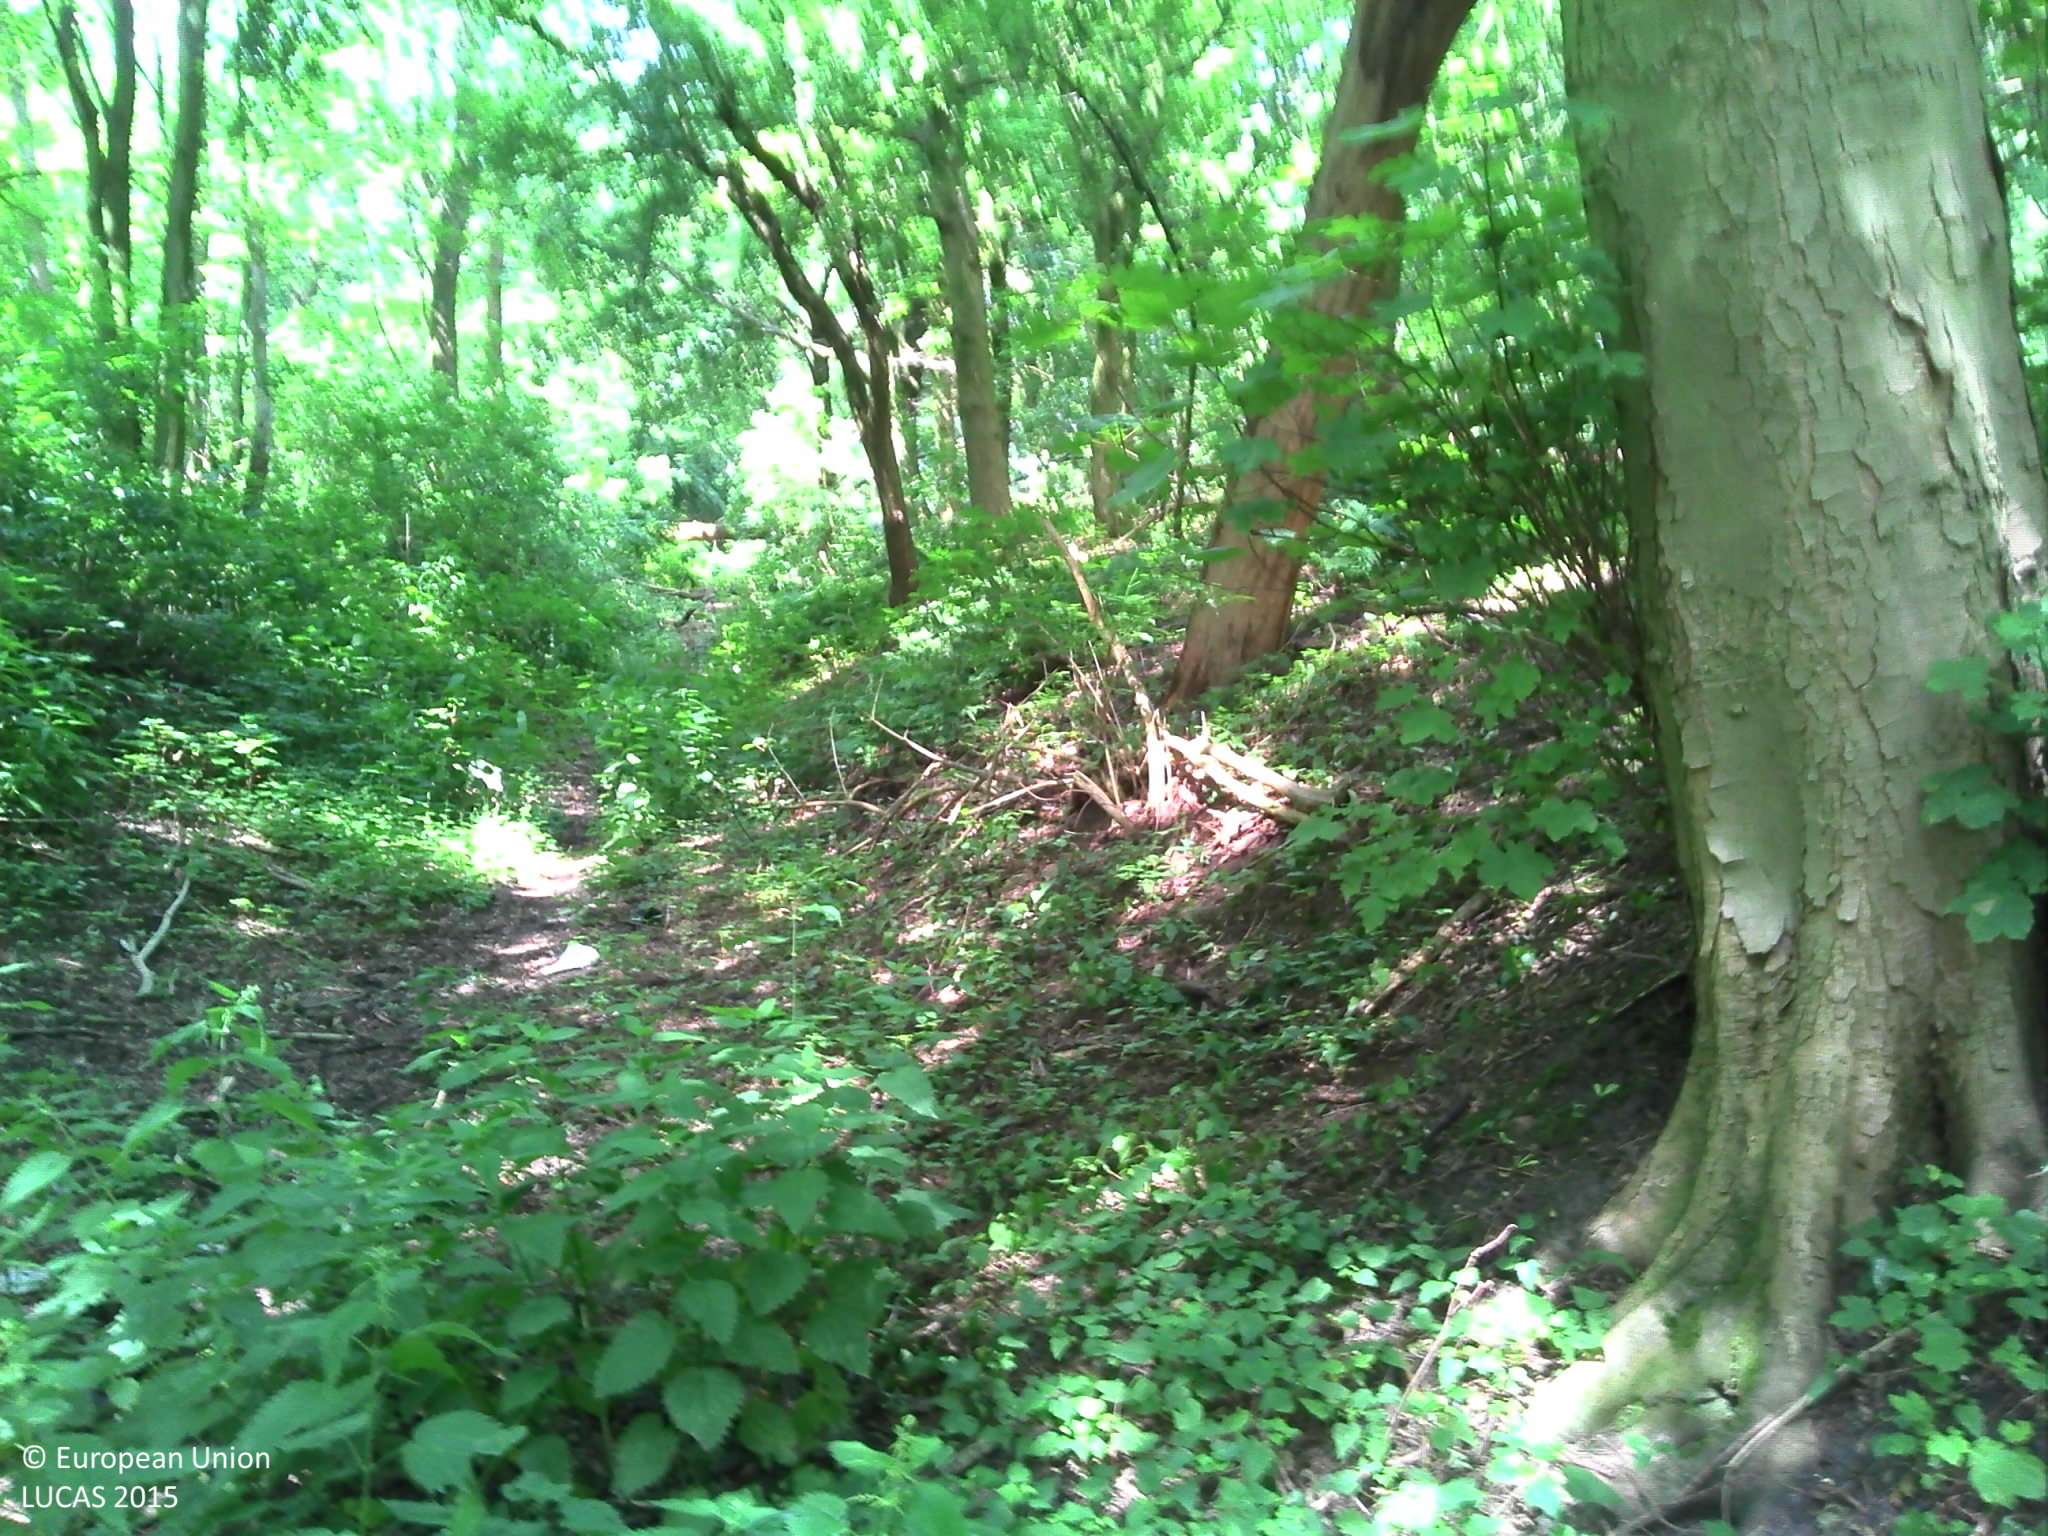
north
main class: Woodland
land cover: Broadleaved woodland
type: mesophytic deciduous forest
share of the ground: > 75 %
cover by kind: broadleaved forest trees 60 %, herbaceous plants 30 %, unconsolidated bare surface 10 %
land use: Forestry
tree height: > 5 m
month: June
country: BE
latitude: 50.4848
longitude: 3.8063
